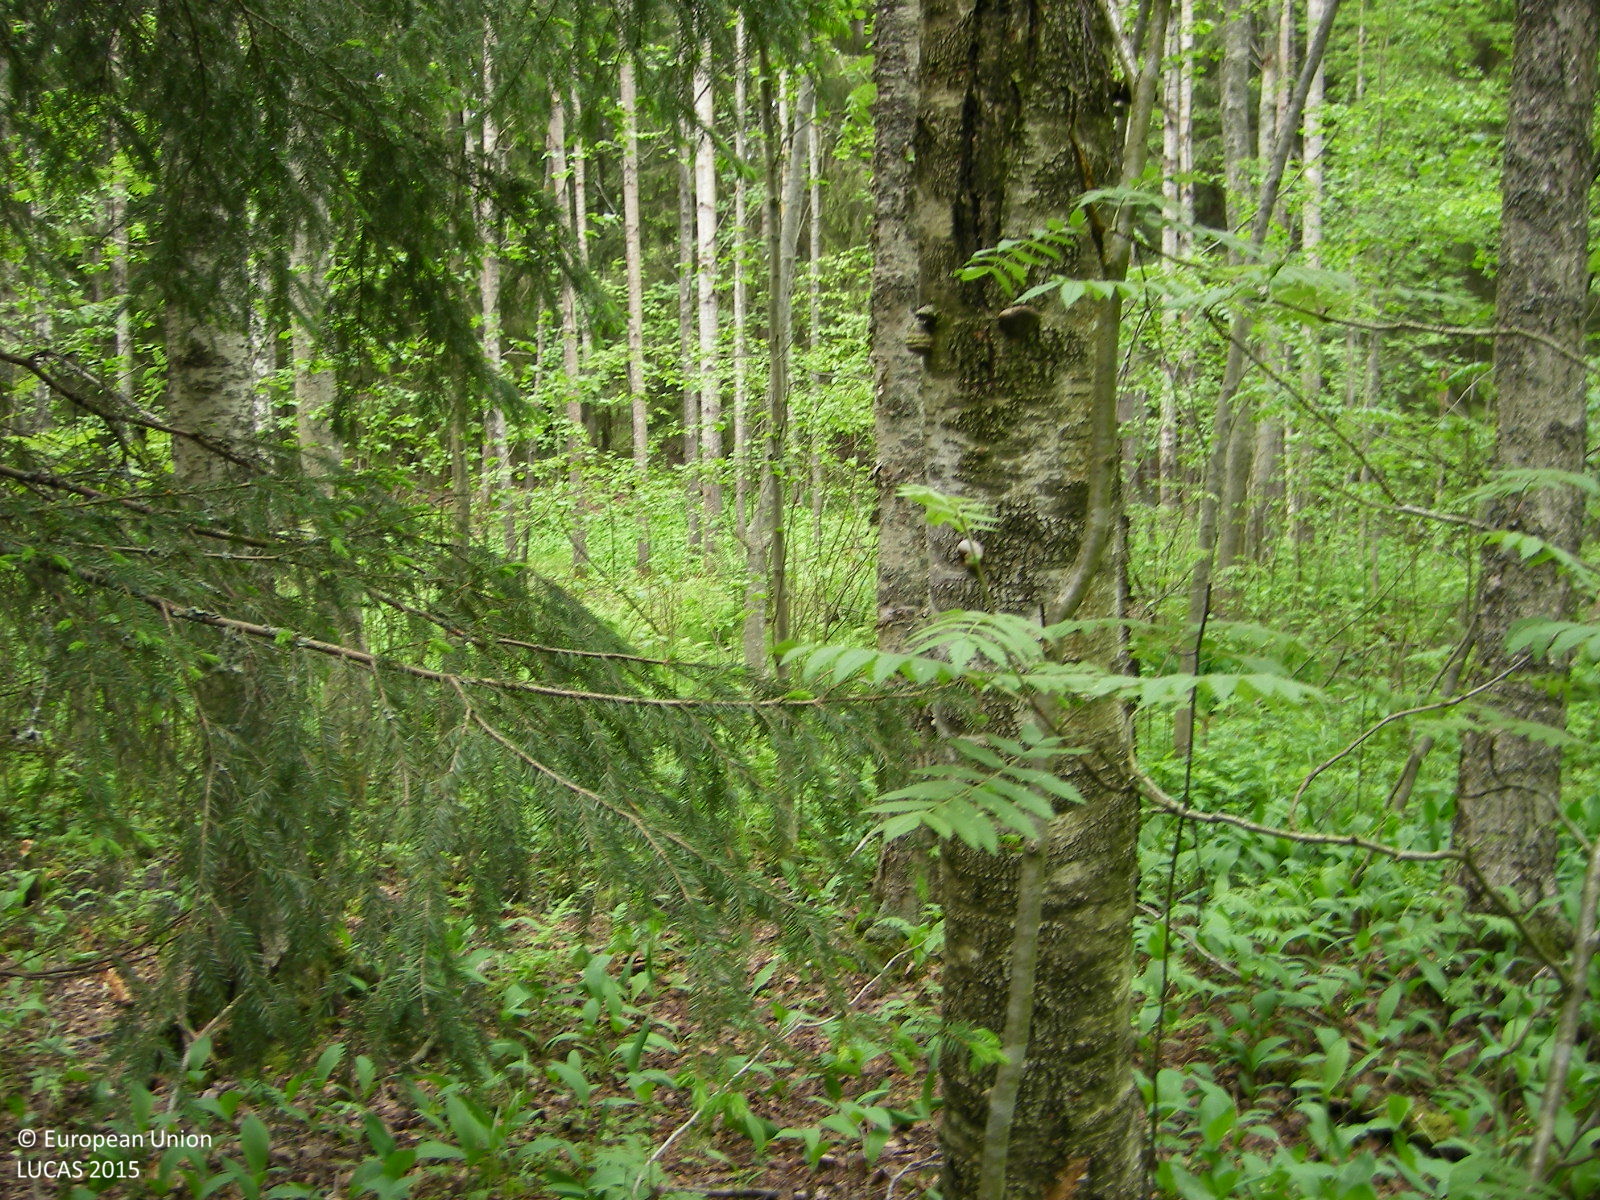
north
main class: Woodland
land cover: Spruce dominated mixed woodland
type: boreal forest
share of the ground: > 75 %
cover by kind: broadleaved forest trees 50 %, coniferous forest trees 40 %, herbaceous plants 10 %
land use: Semi-natural and natural areas not in use
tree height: > 5 m
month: June
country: FI
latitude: 60.1935
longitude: 24.7037
